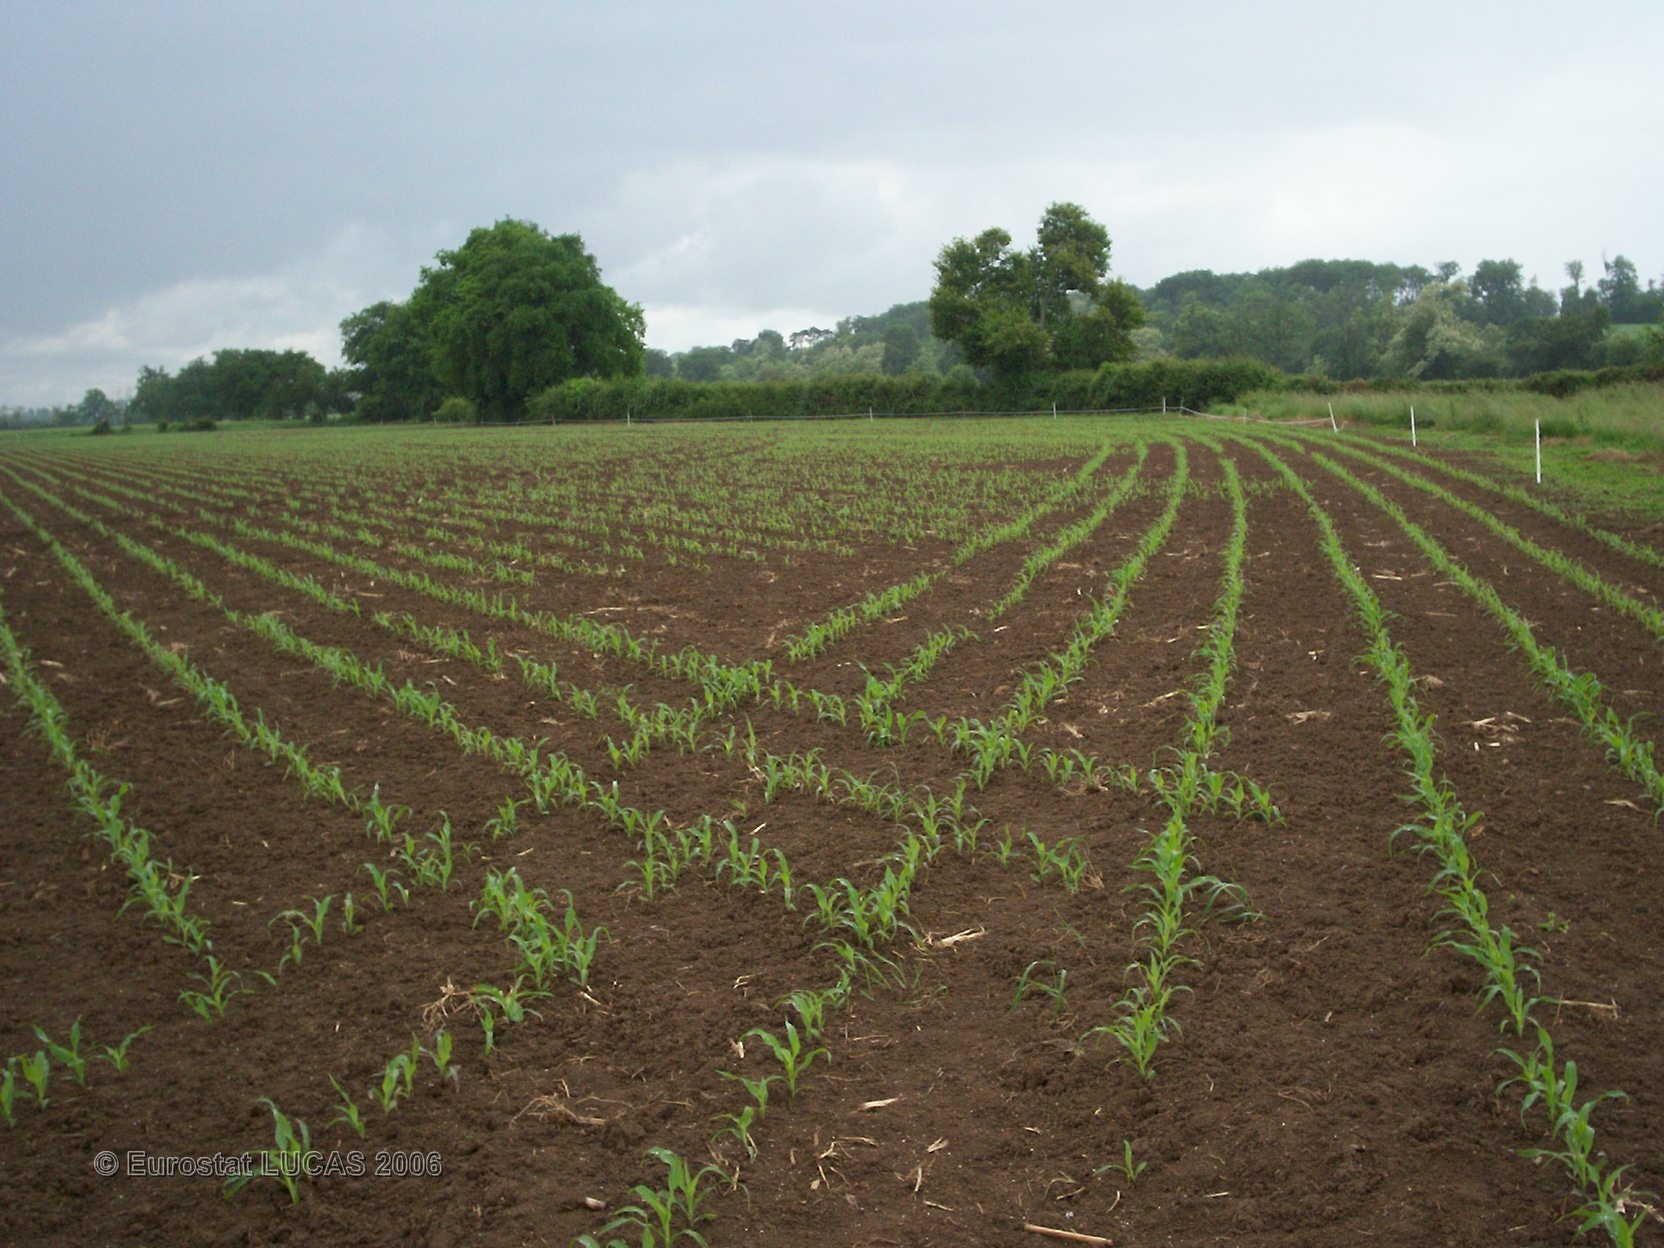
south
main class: Cropland
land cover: Maize
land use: Agriculture (excluding fallow land and kitchen gardens)
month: May
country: FR
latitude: 47.1872
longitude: 2.9874
